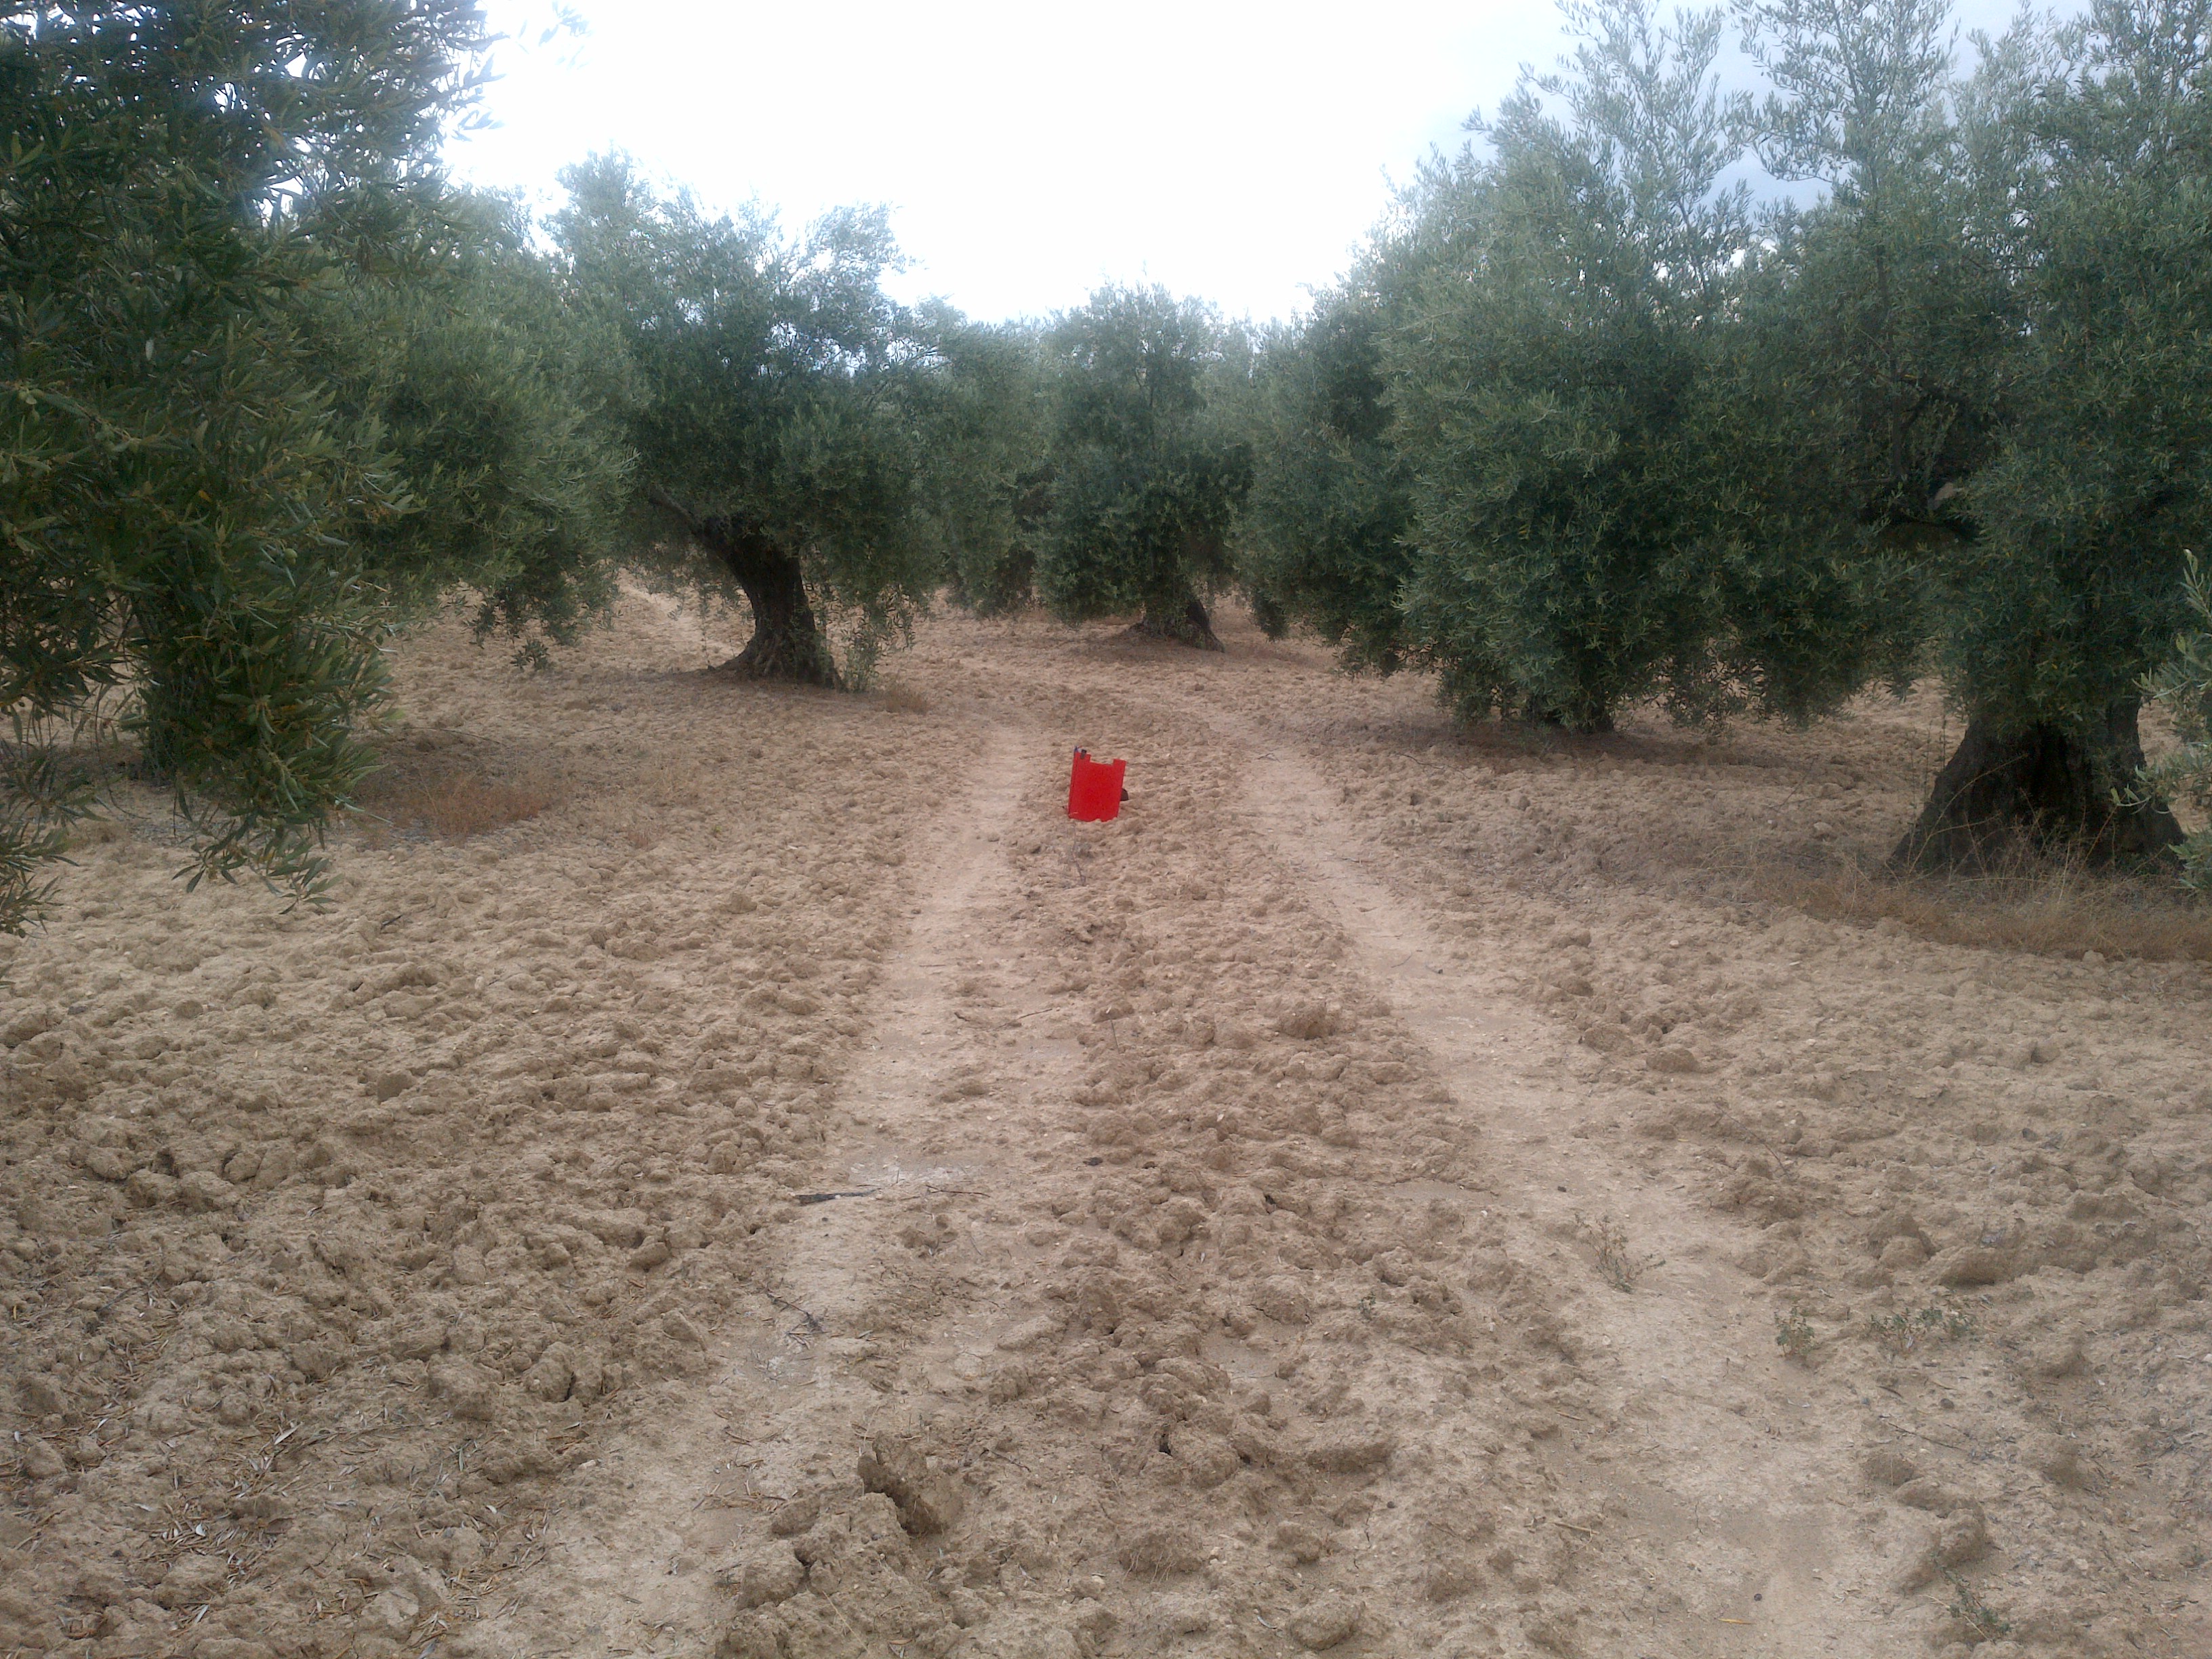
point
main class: Cropland
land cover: Olive groves
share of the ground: 50 - 75 %
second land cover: Other bare soil
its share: > 75 %
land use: Agriculture (excluding fallow land and kitchen gardens)
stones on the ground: 10 - 25 %
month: June
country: ES
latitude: 37.9307
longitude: -4.2873
